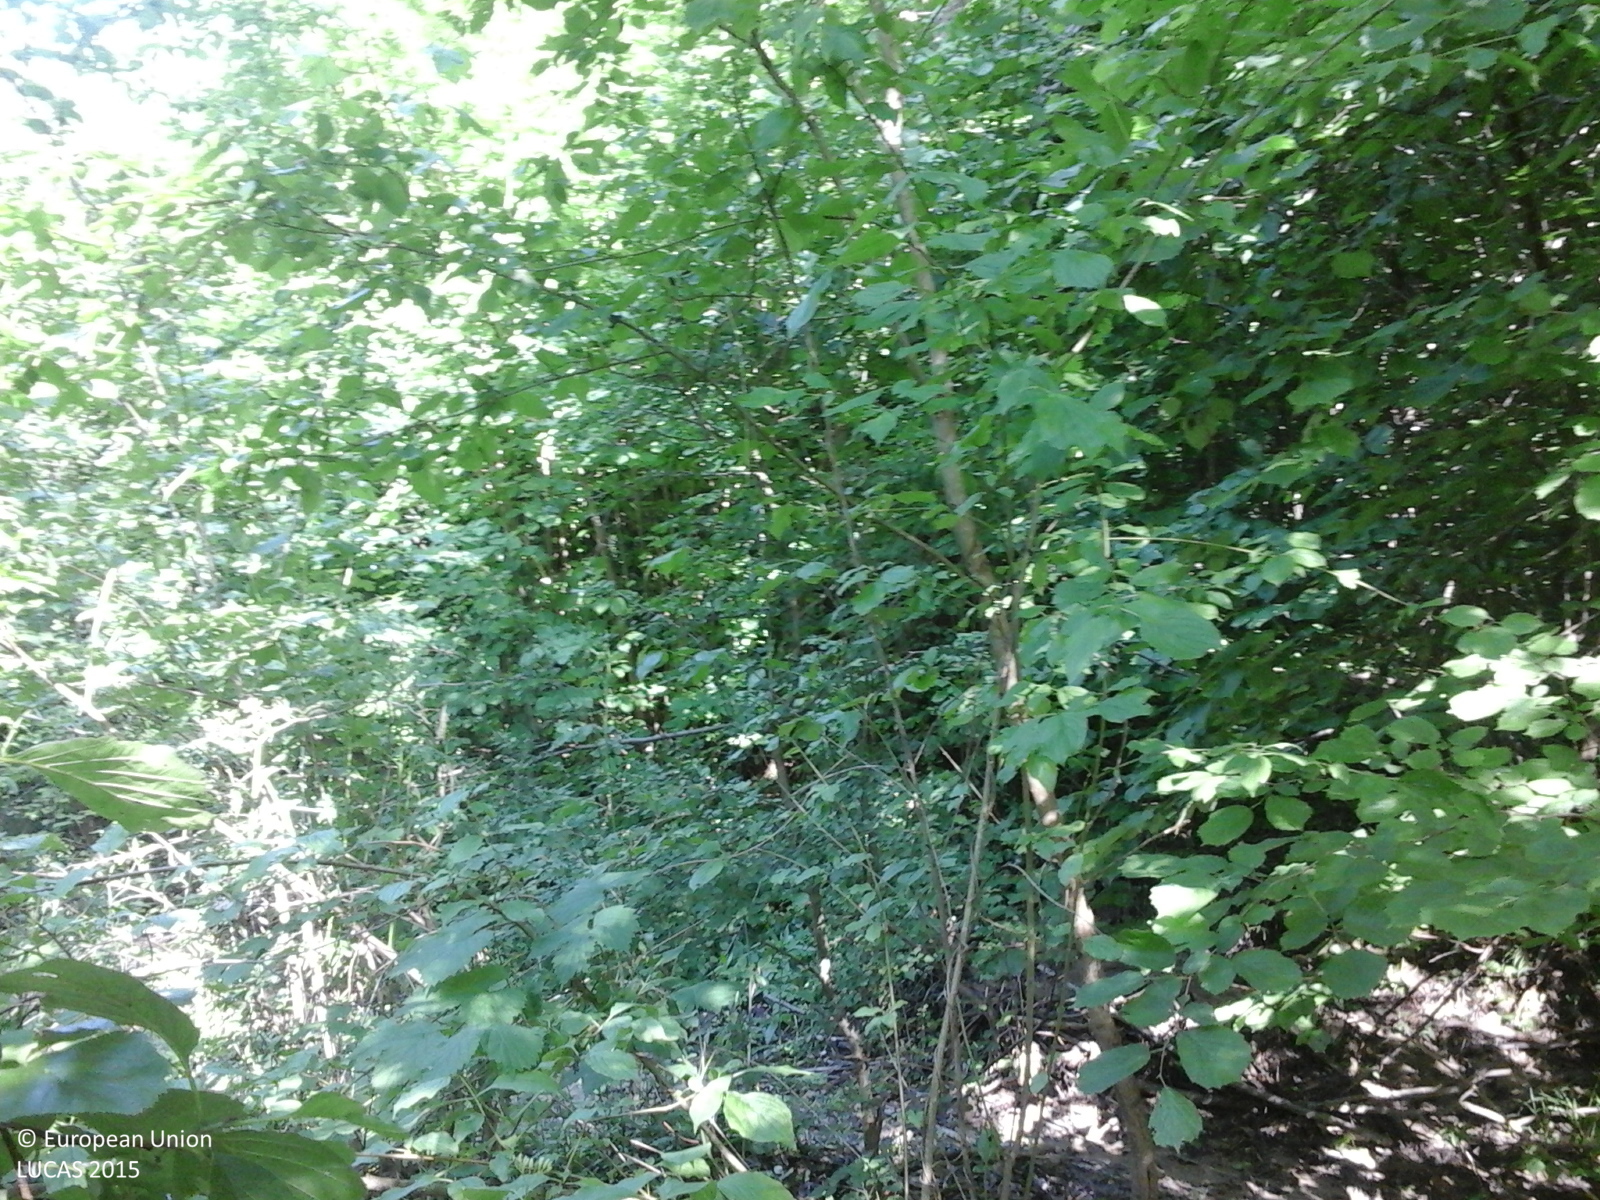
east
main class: Woodland
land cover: Broadleaved woodland
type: mesophytic deciduous forest
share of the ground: > 75 %
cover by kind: broadleaved forest trees 100 %
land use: Forestry
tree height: > 5 m
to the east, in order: Broadleaved woodland; Grassland without tree/shrub cover; Broadleaved woodland
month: May
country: RO
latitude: 45.2026
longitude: 26.1678
